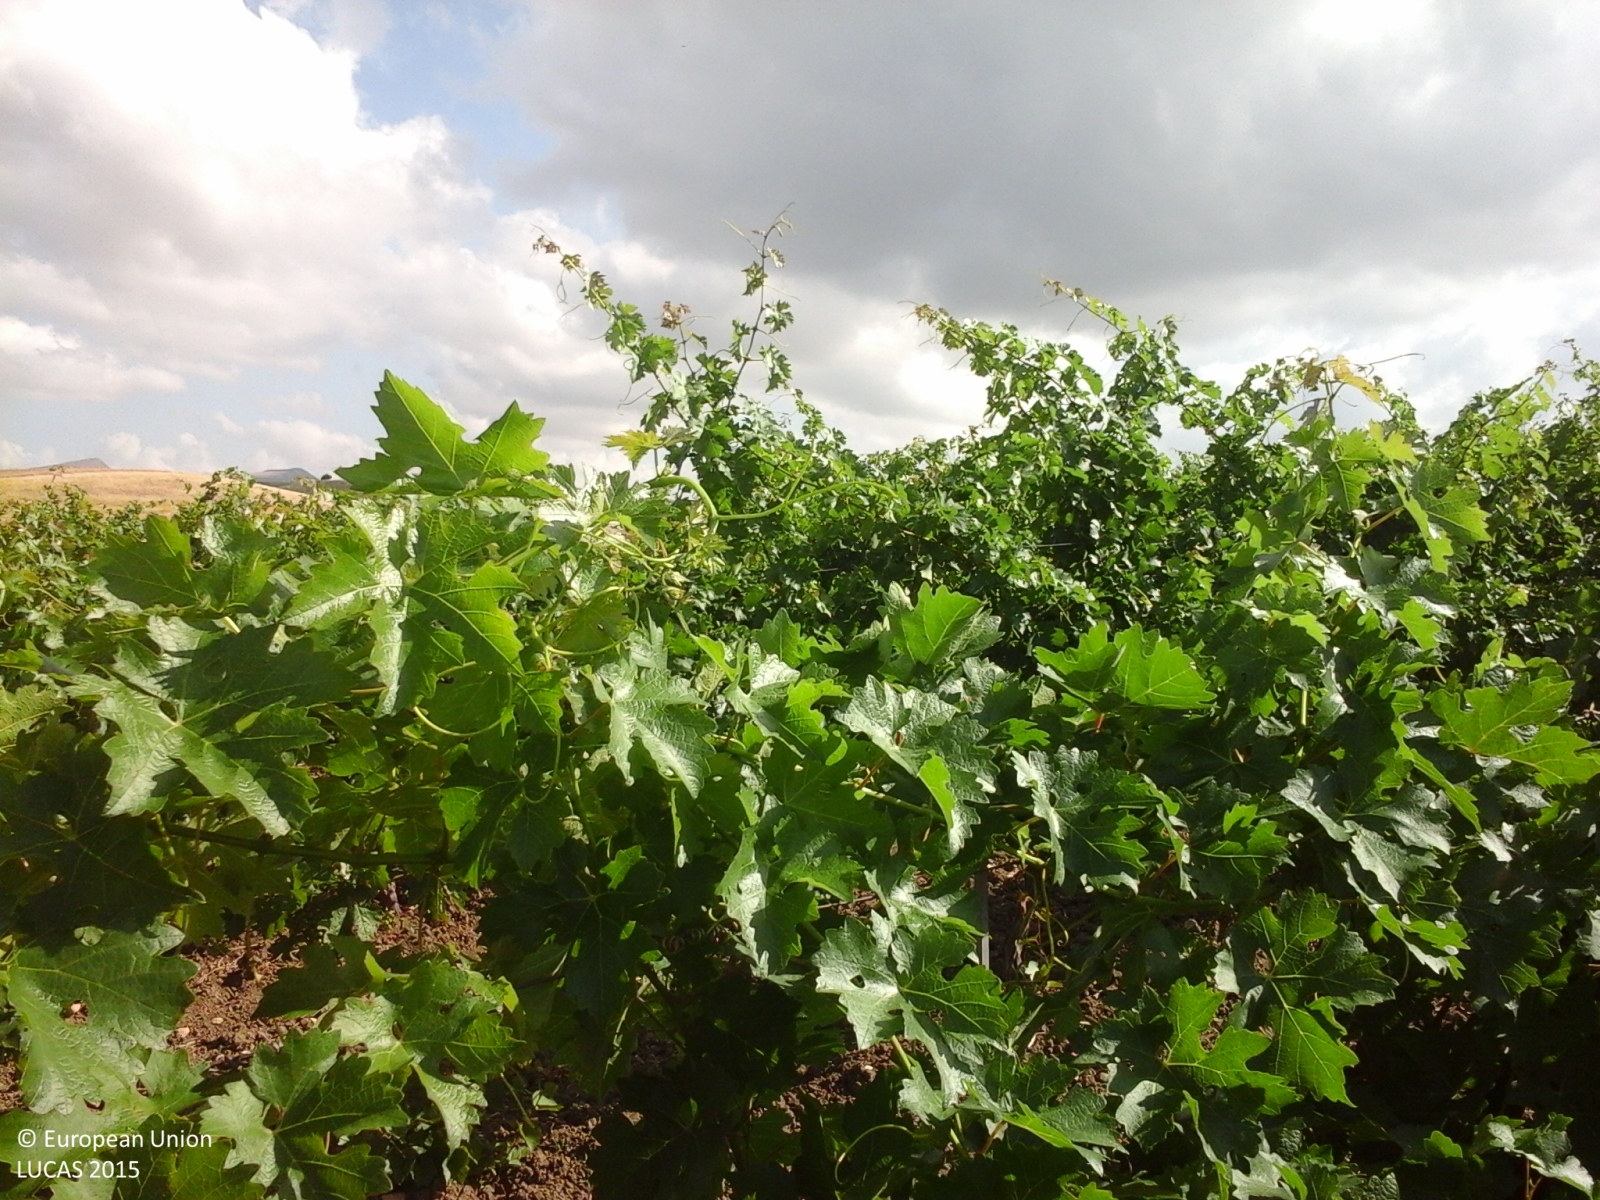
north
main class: Cropland
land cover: Vineyards
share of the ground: 50 - 75 %
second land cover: Other bare soil
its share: > 75 %
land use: Agriculture (excluding fallow land and kitchen gardens)
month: June
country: IT
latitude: 37.7168
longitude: 13.0515
